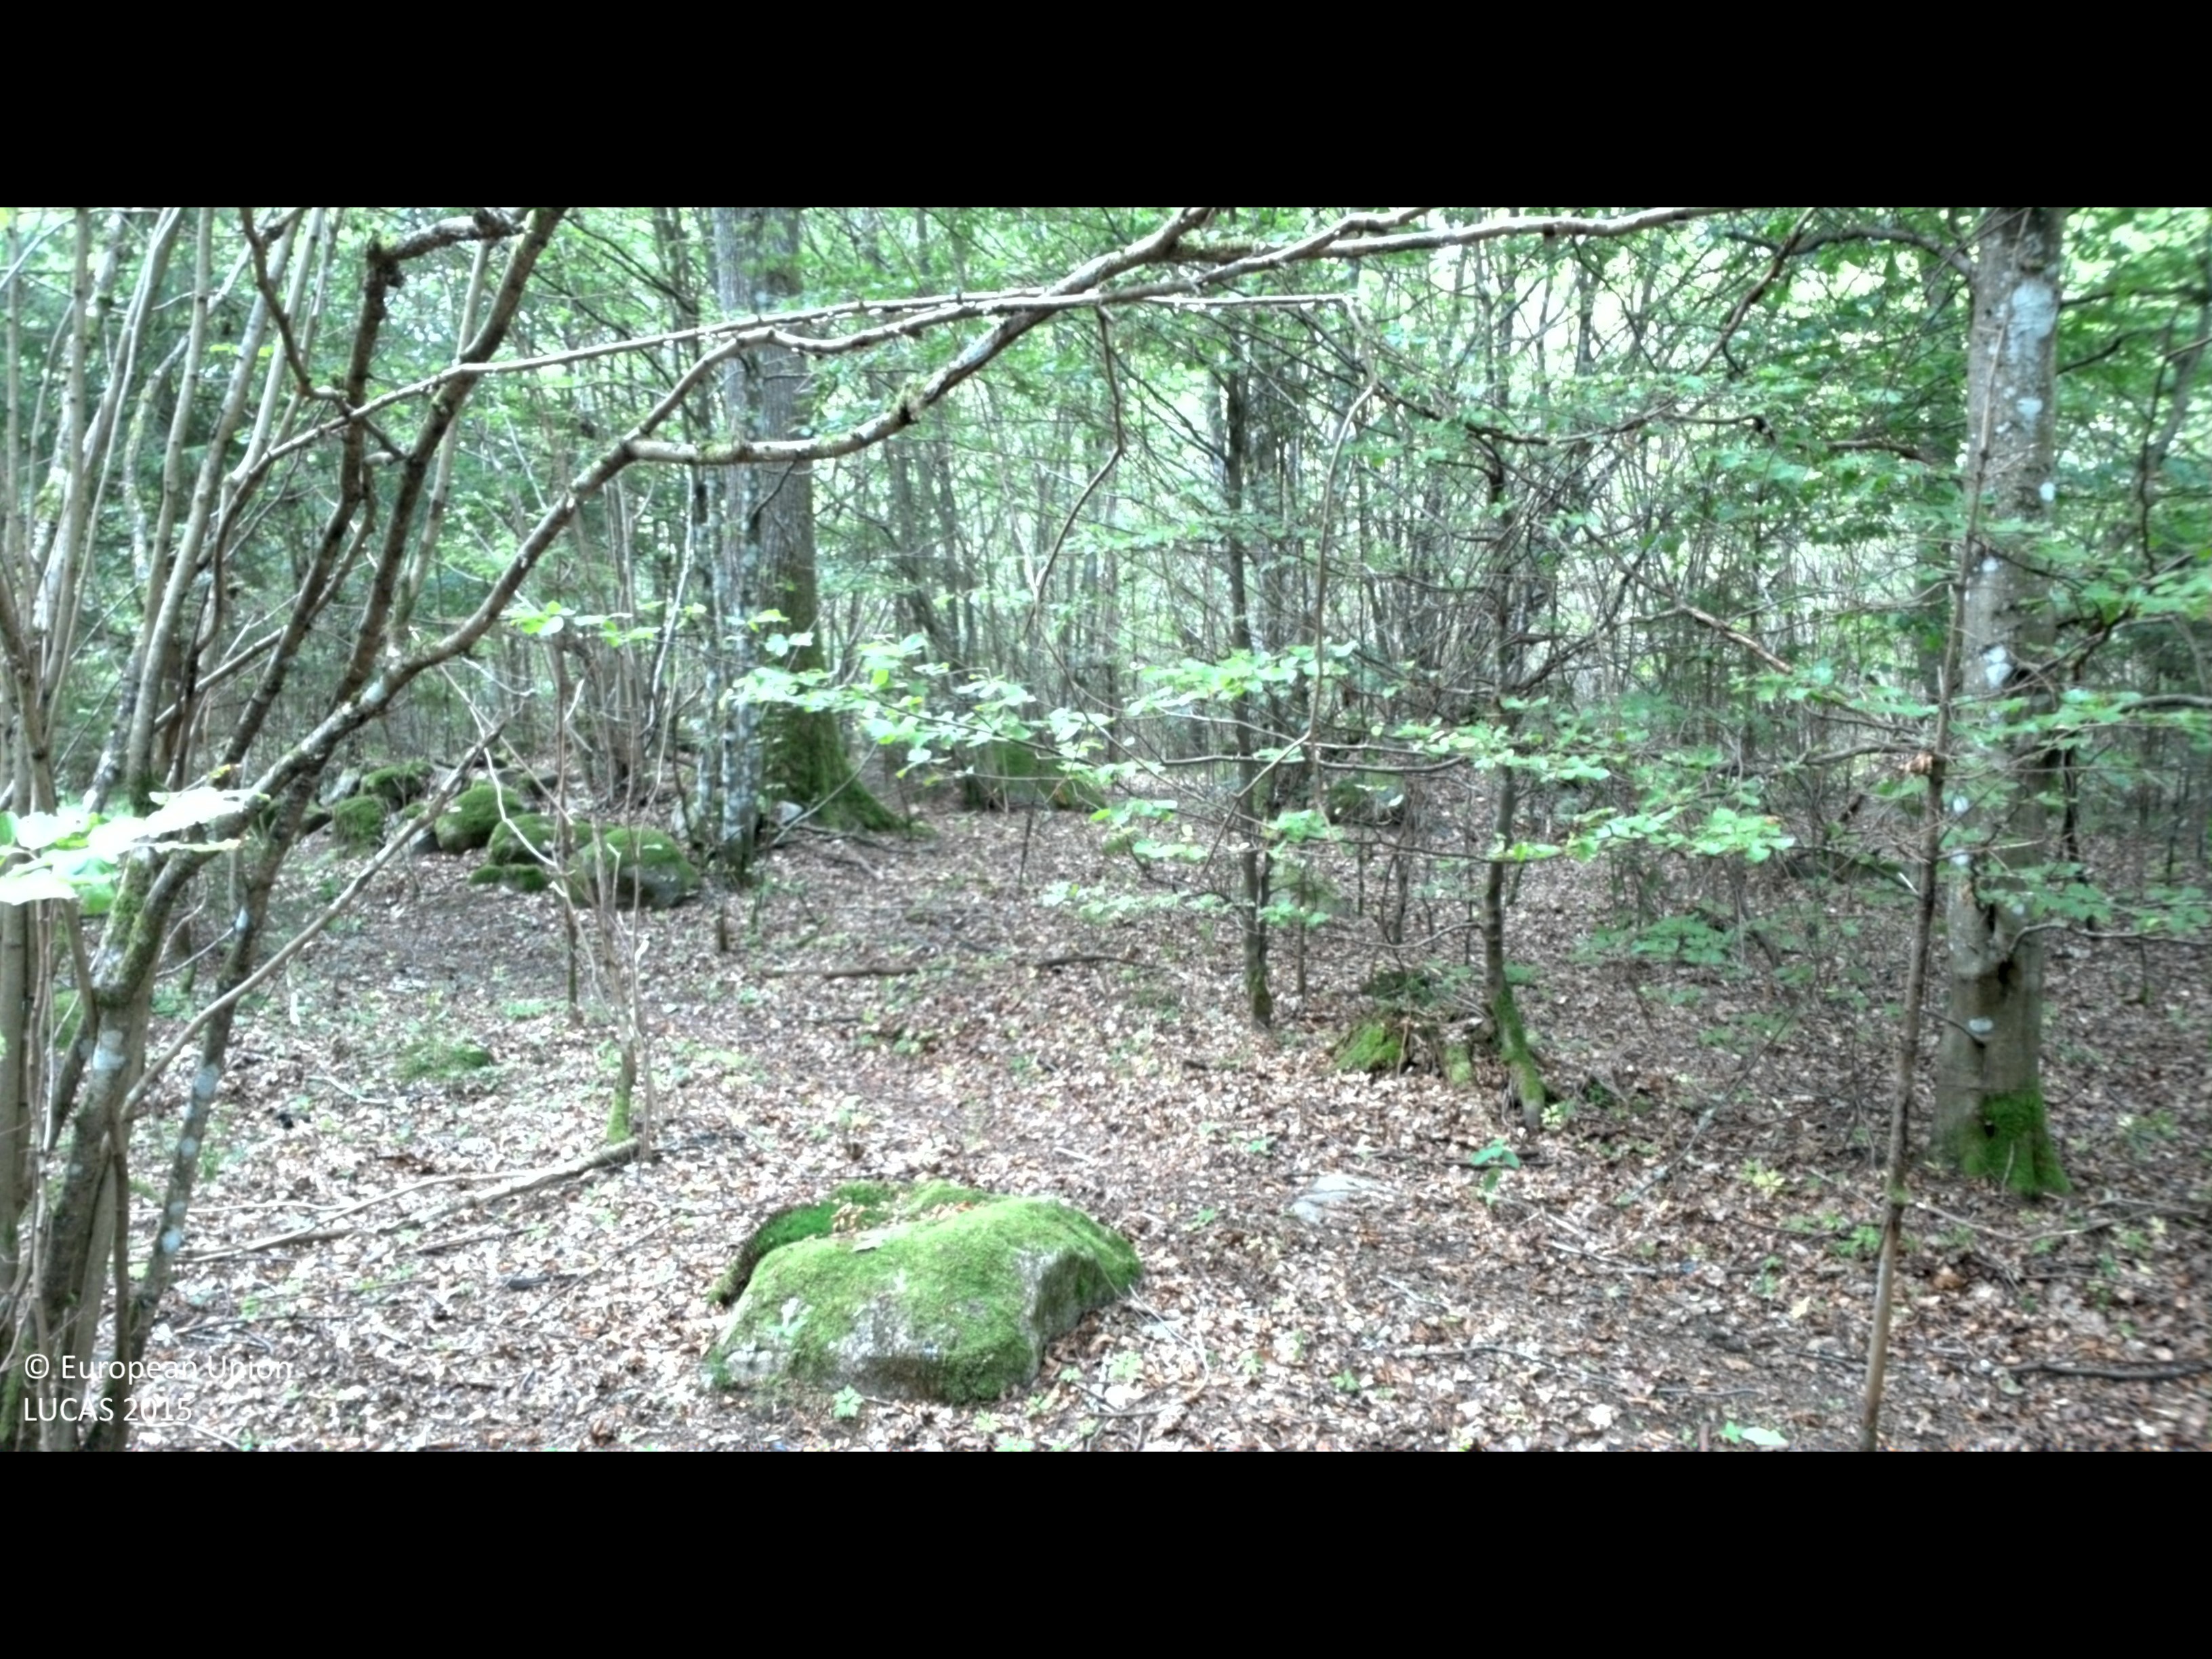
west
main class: Woodland
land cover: Broadleaved woodland
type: mesophytic deciduous forest
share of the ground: 50 - 75 %
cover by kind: broadleaved forest trees 50 %, shrubs 30 %, herbaceous plants 15 %, coniferous forest trees 5 %
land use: Forestry
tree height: > 5 m
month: July
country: SE
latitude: 56.2528
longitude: 15.4387
